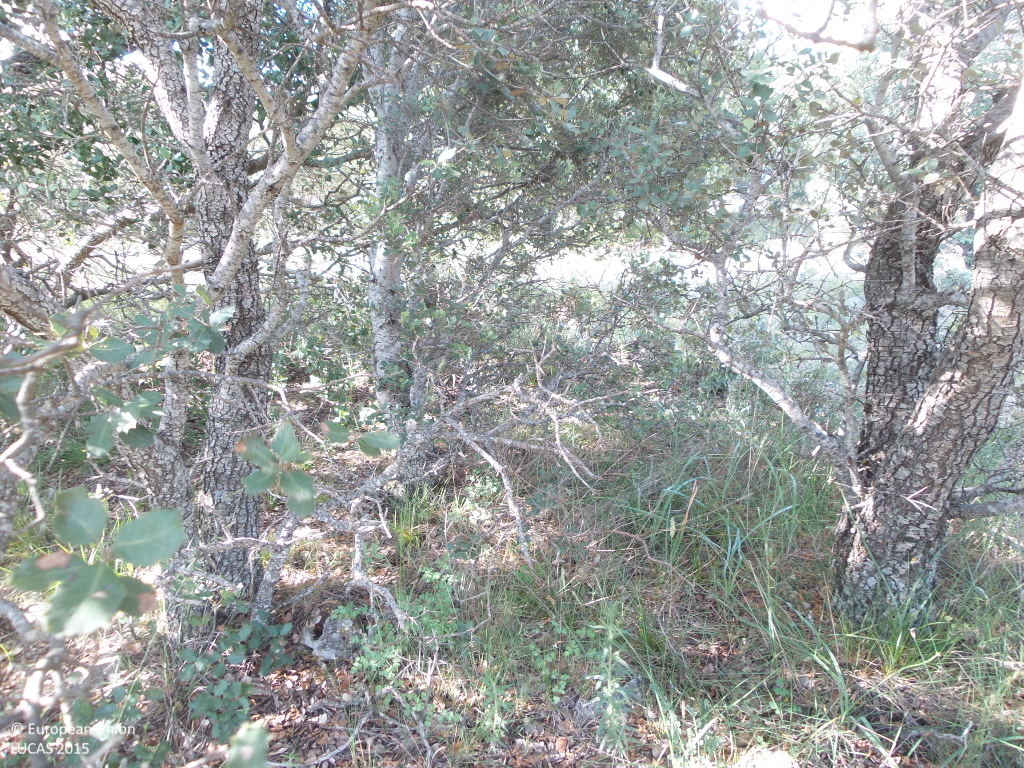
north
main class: Woodland
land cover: Broadleaved woodland
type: broadleaved evergreen forest
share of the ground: 50 - 75 %
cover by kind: broadleaved forest trees 50 %, shrubs 30 %, herbaceous plants 10 %, unconsolidated bare surface 10 %
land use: Semi-natural and natural areas not in use
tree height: < 5 m
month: June
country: ES
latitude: 41.3783
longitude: -2.9653
